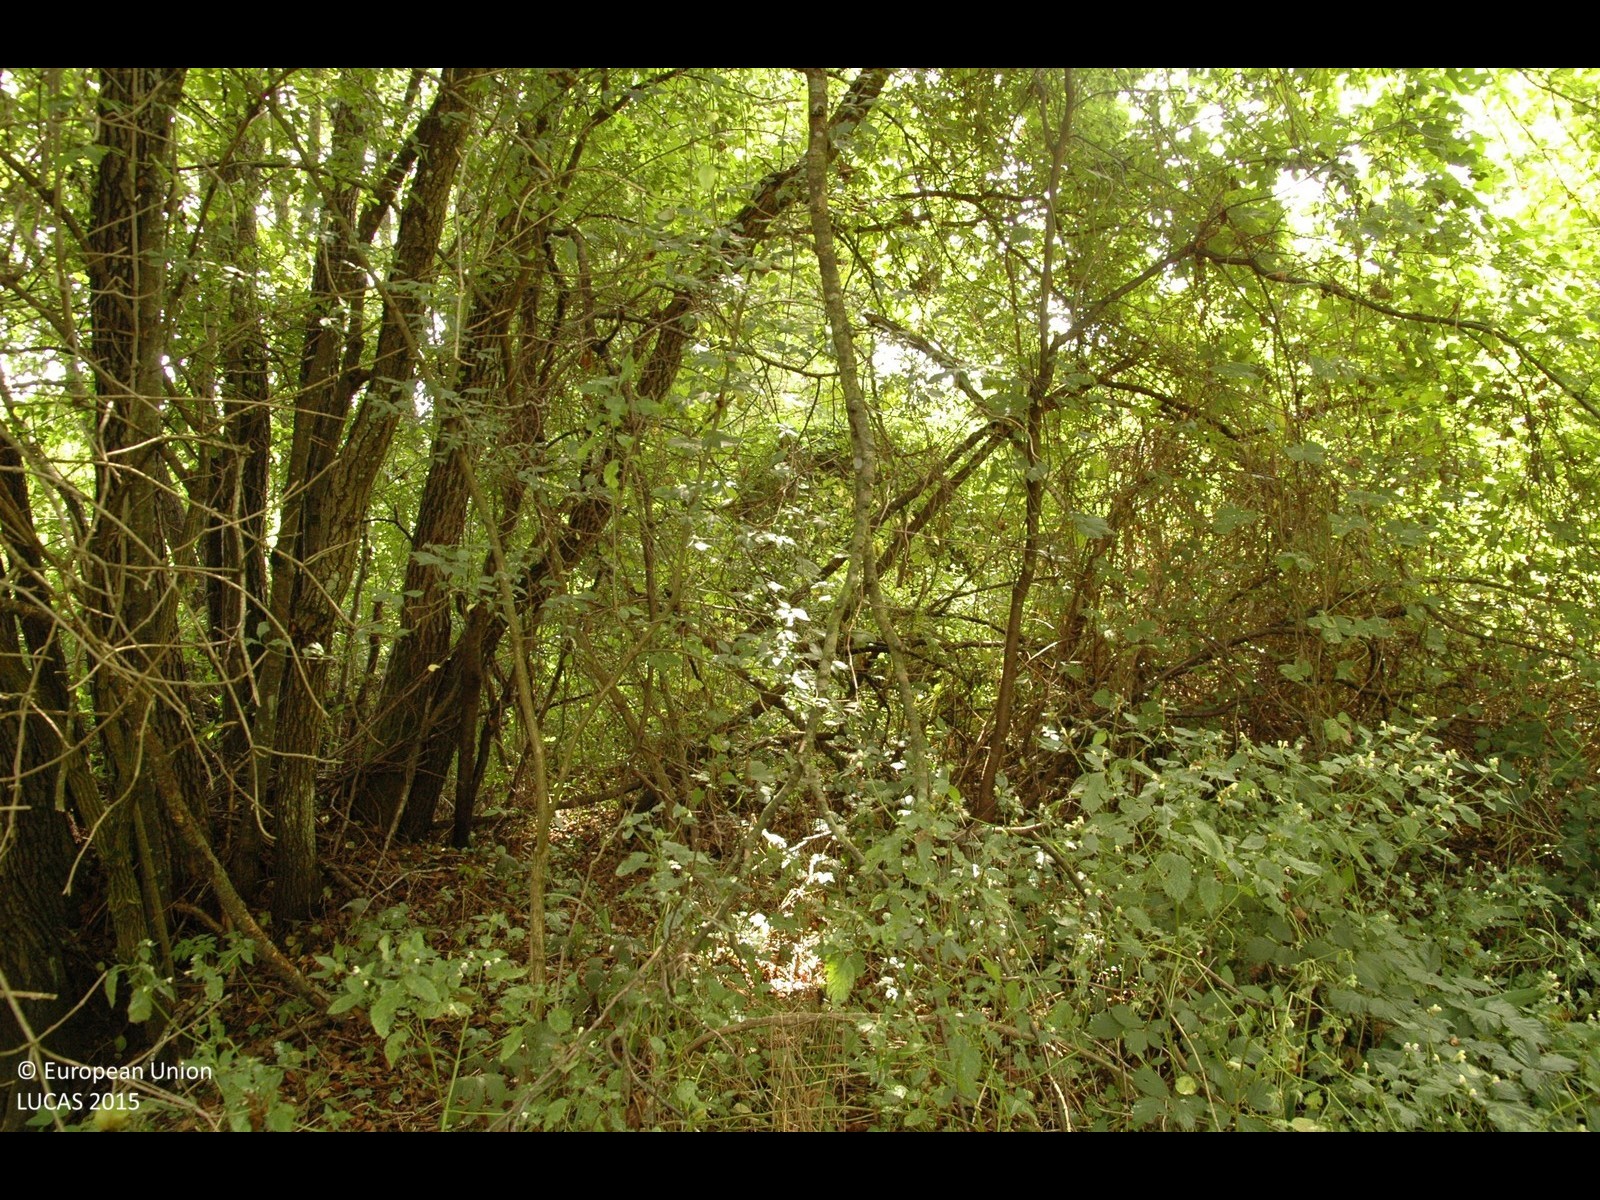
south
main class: Woodland
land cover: Broadleaved woodland
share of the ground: > 75 %
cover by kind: broadleaved forest trees 100 %
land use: Forestry
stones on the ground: < 10 %
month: September
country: HR
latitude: 45.5711
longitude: 15.9556
